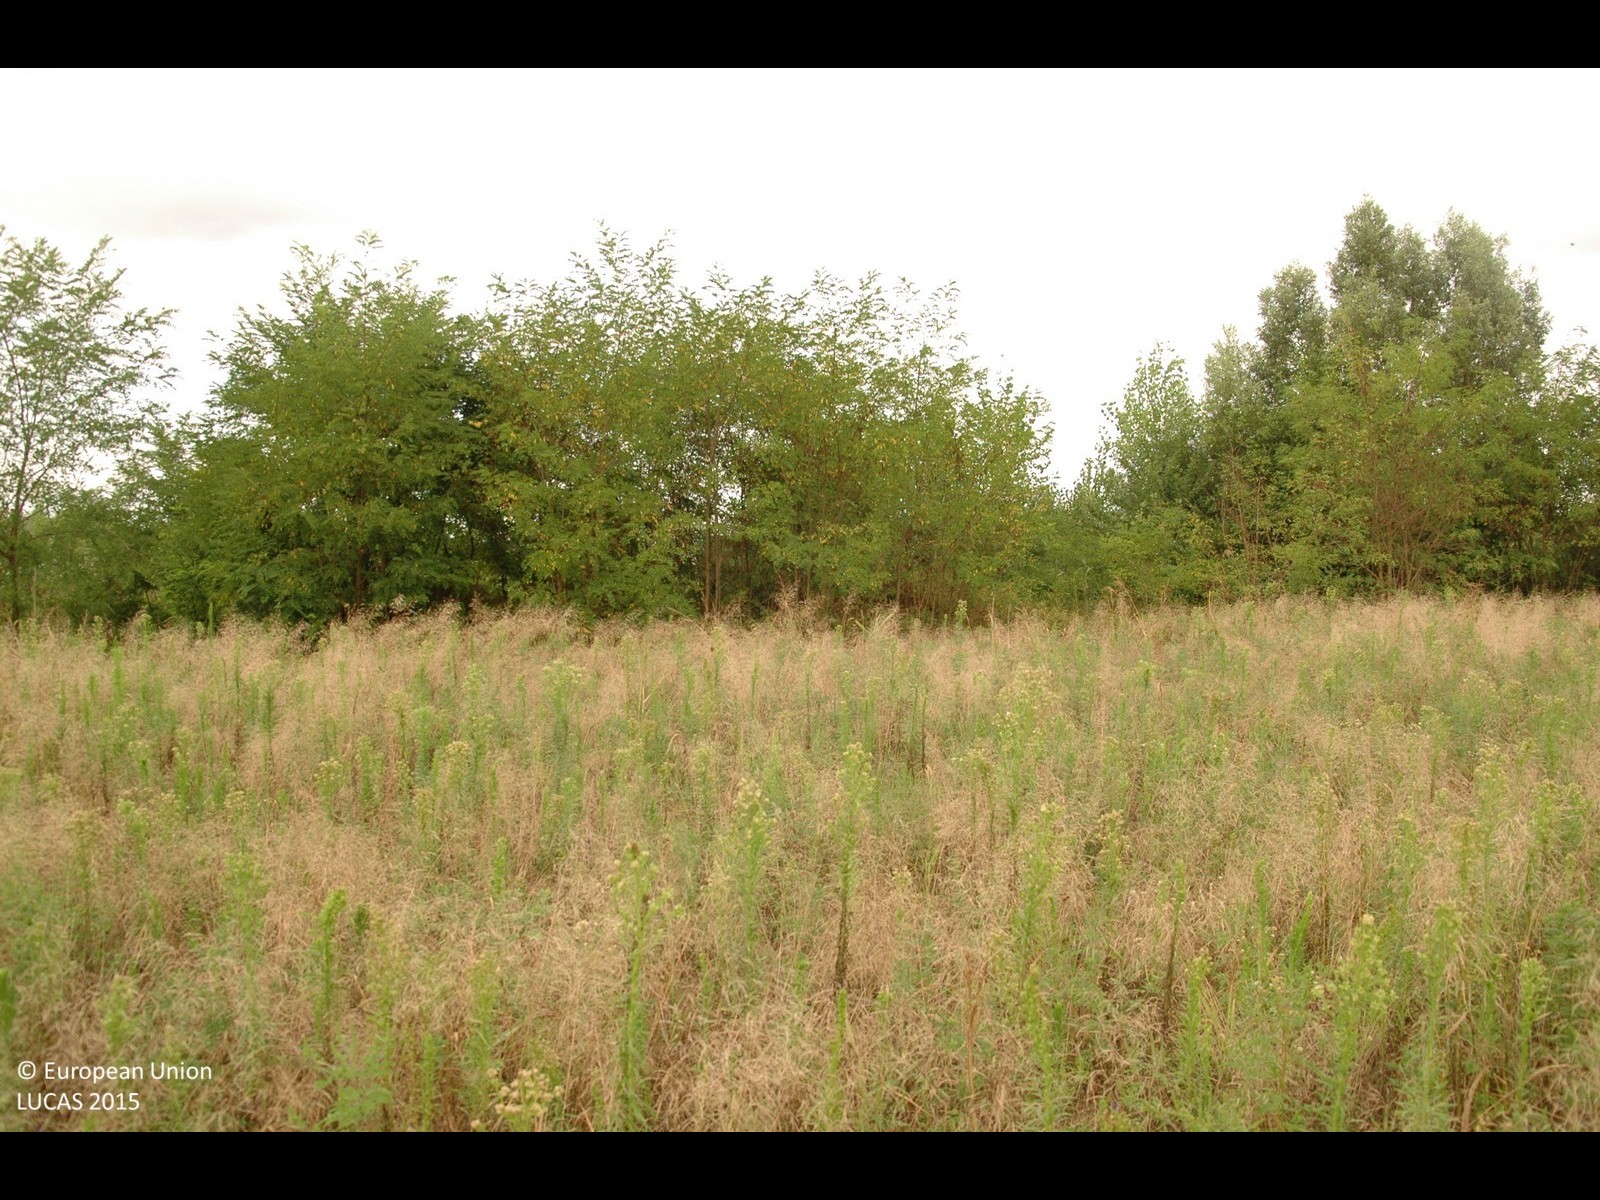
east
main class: Grassland
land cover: Grassland without tree/shrub cover
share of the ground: > 75 %
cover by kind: herbaceous plants 100 %
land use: Agriculture (excluding fallow land and kitchen gardens)
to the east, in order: Grassland without tree/shrub cover; Tracks; Abandoned hedges; Ponds and wetlands; Shrubland with sparse tree cover; Tracks; Shrubland with sparse tree cover
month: August
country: HR
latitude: 46.1983
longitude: 16.9347
